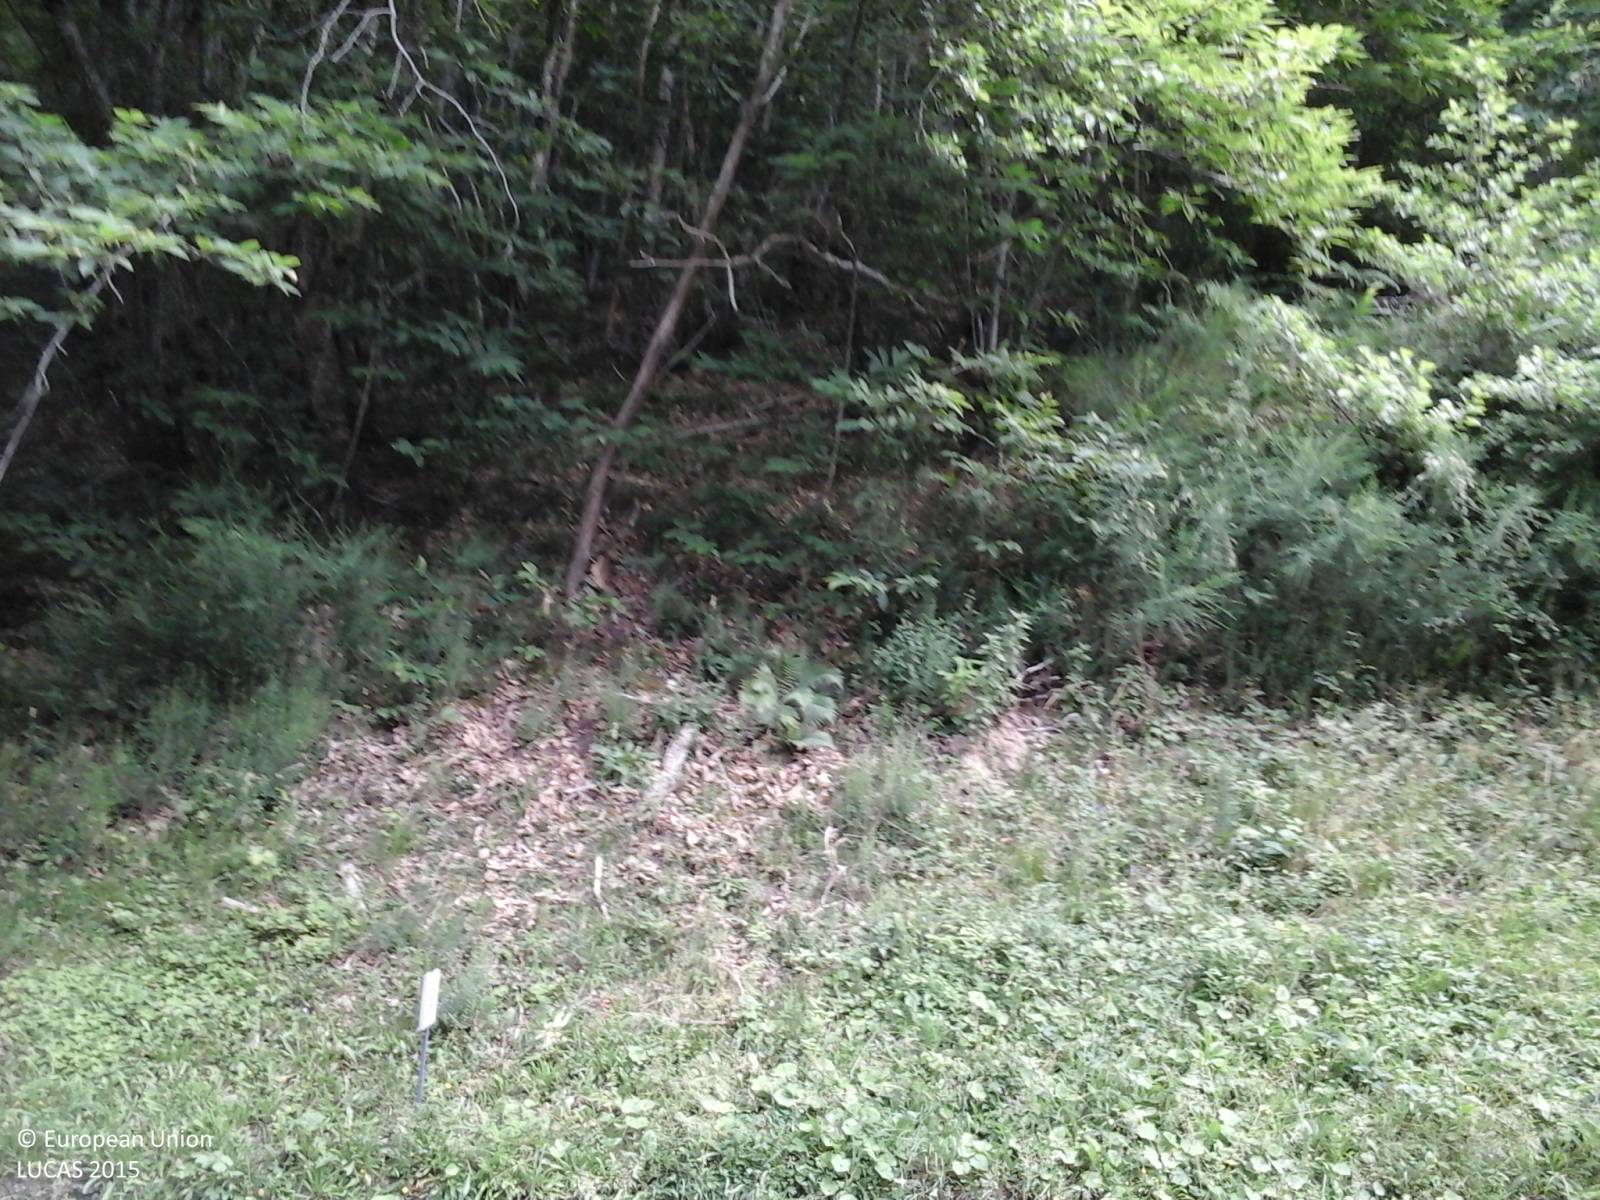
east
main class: Woodland
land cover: Broadleaved woodland
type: thermophilous deciduous forest
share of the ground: > 75 %
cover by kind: broadleaved forest trees 100 %
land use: Forestry
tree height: > 5 m
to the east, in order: Broadleaved woodland
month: June
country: IT
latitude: 44.1335
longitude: 10.3367
